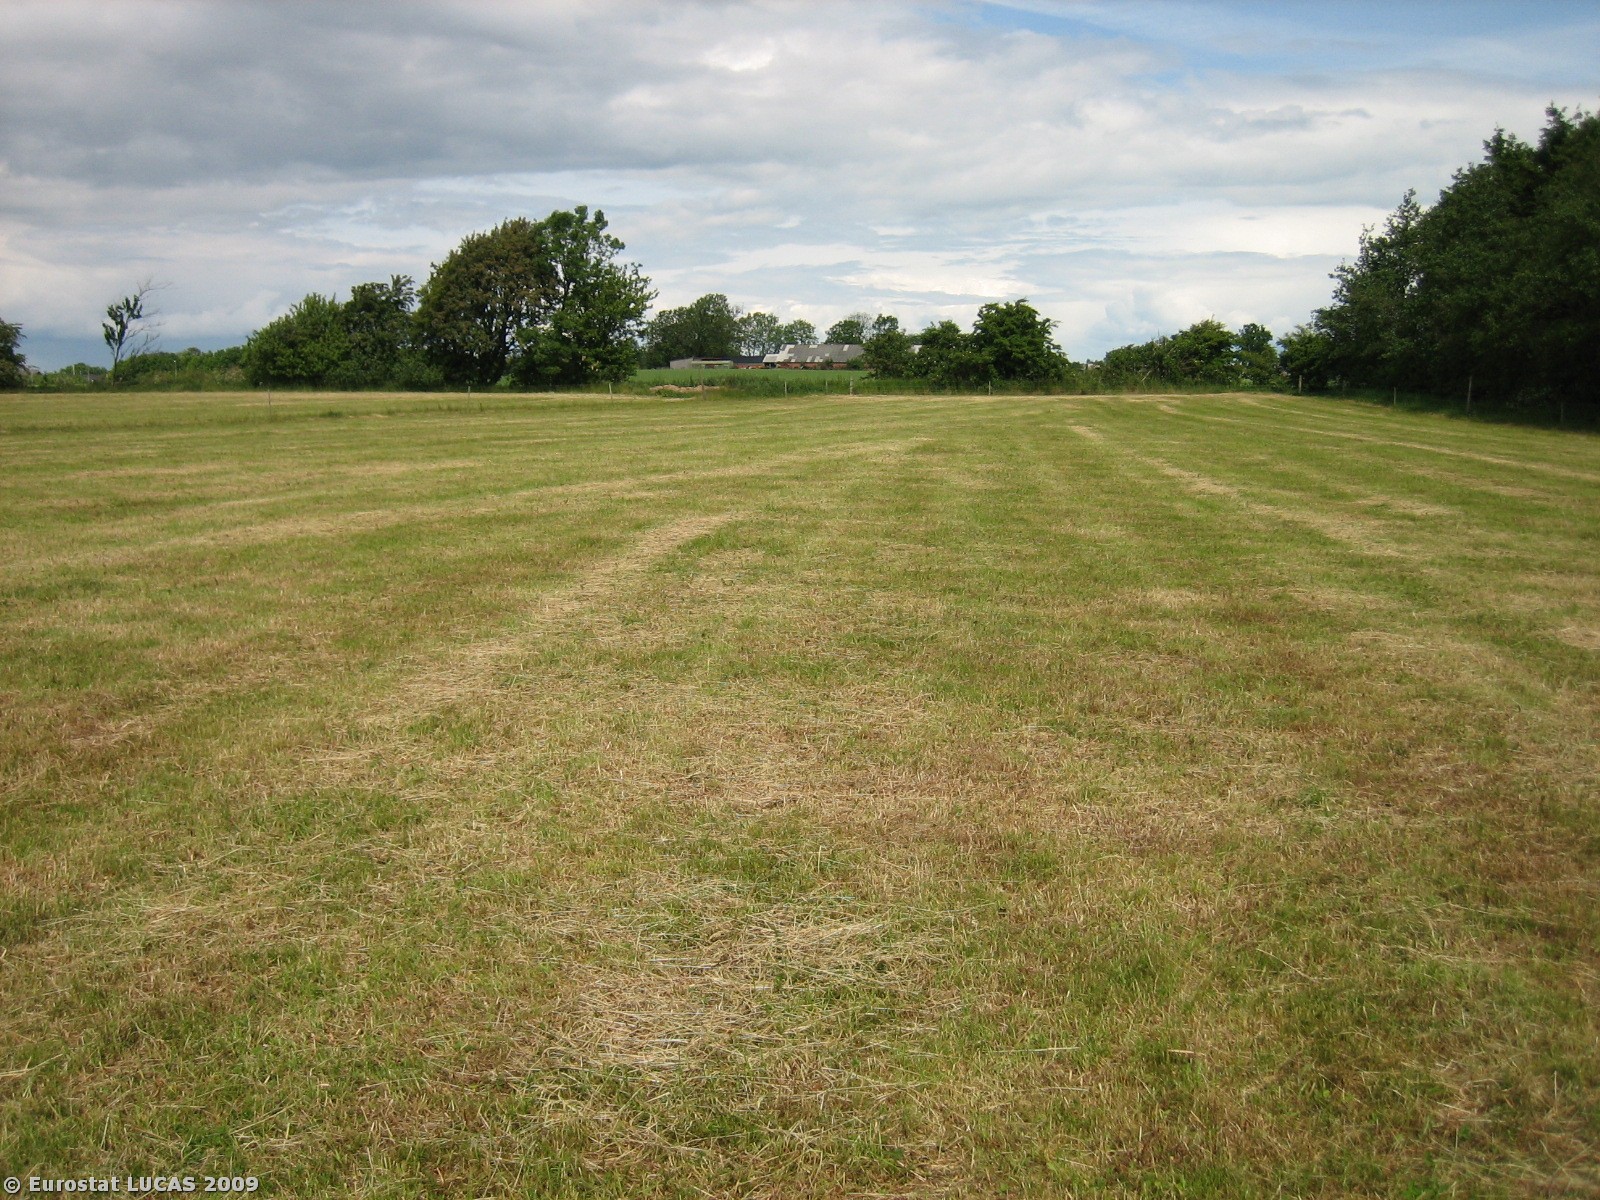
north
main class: Grassland
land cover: Grassland without tree/shrub cover
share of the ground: > 75 %
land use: Agriculture (excluding fallow land and kitchen gardens)
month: June
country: DK
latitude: 56.2593
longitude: 9.7259
